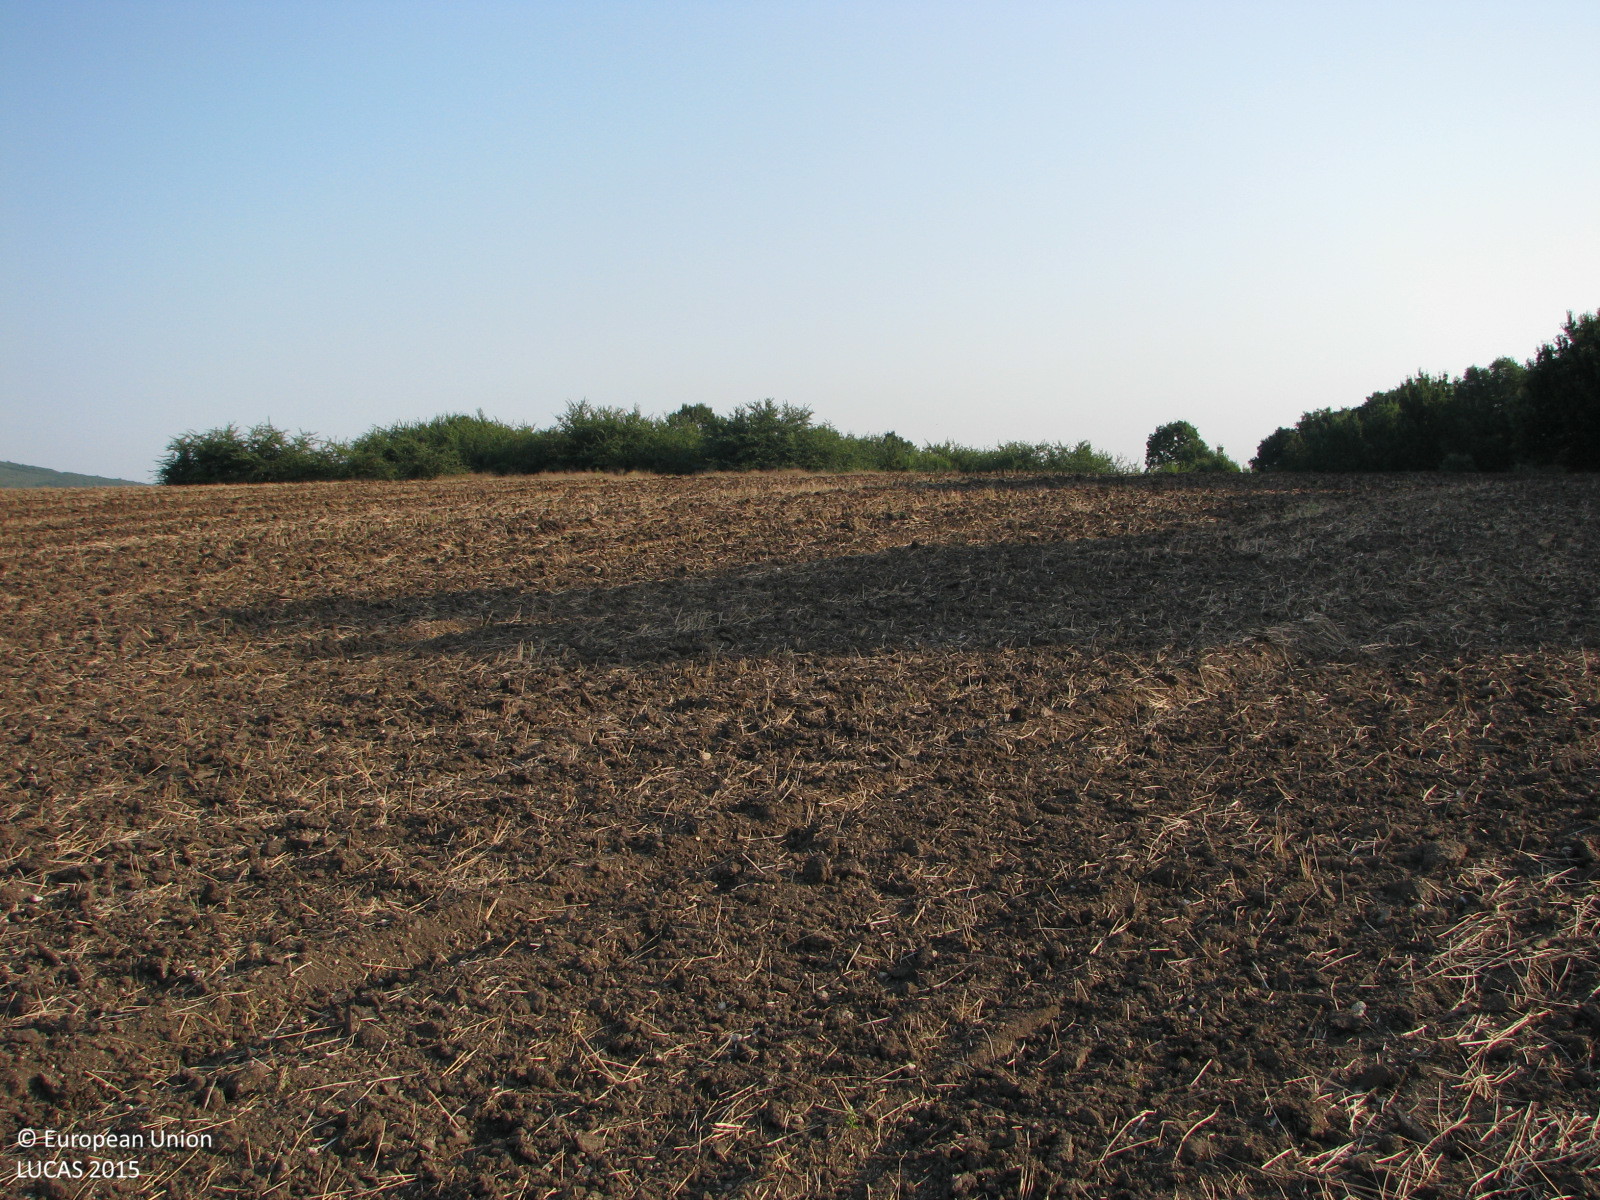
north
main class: Cropland
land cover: Other non-permanent industrial crops
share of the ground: < 10 %
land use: Agriculture (excluding fallow land and kitchen gardens)
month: August
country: BG
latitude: 42.1821
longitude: 26.4439
